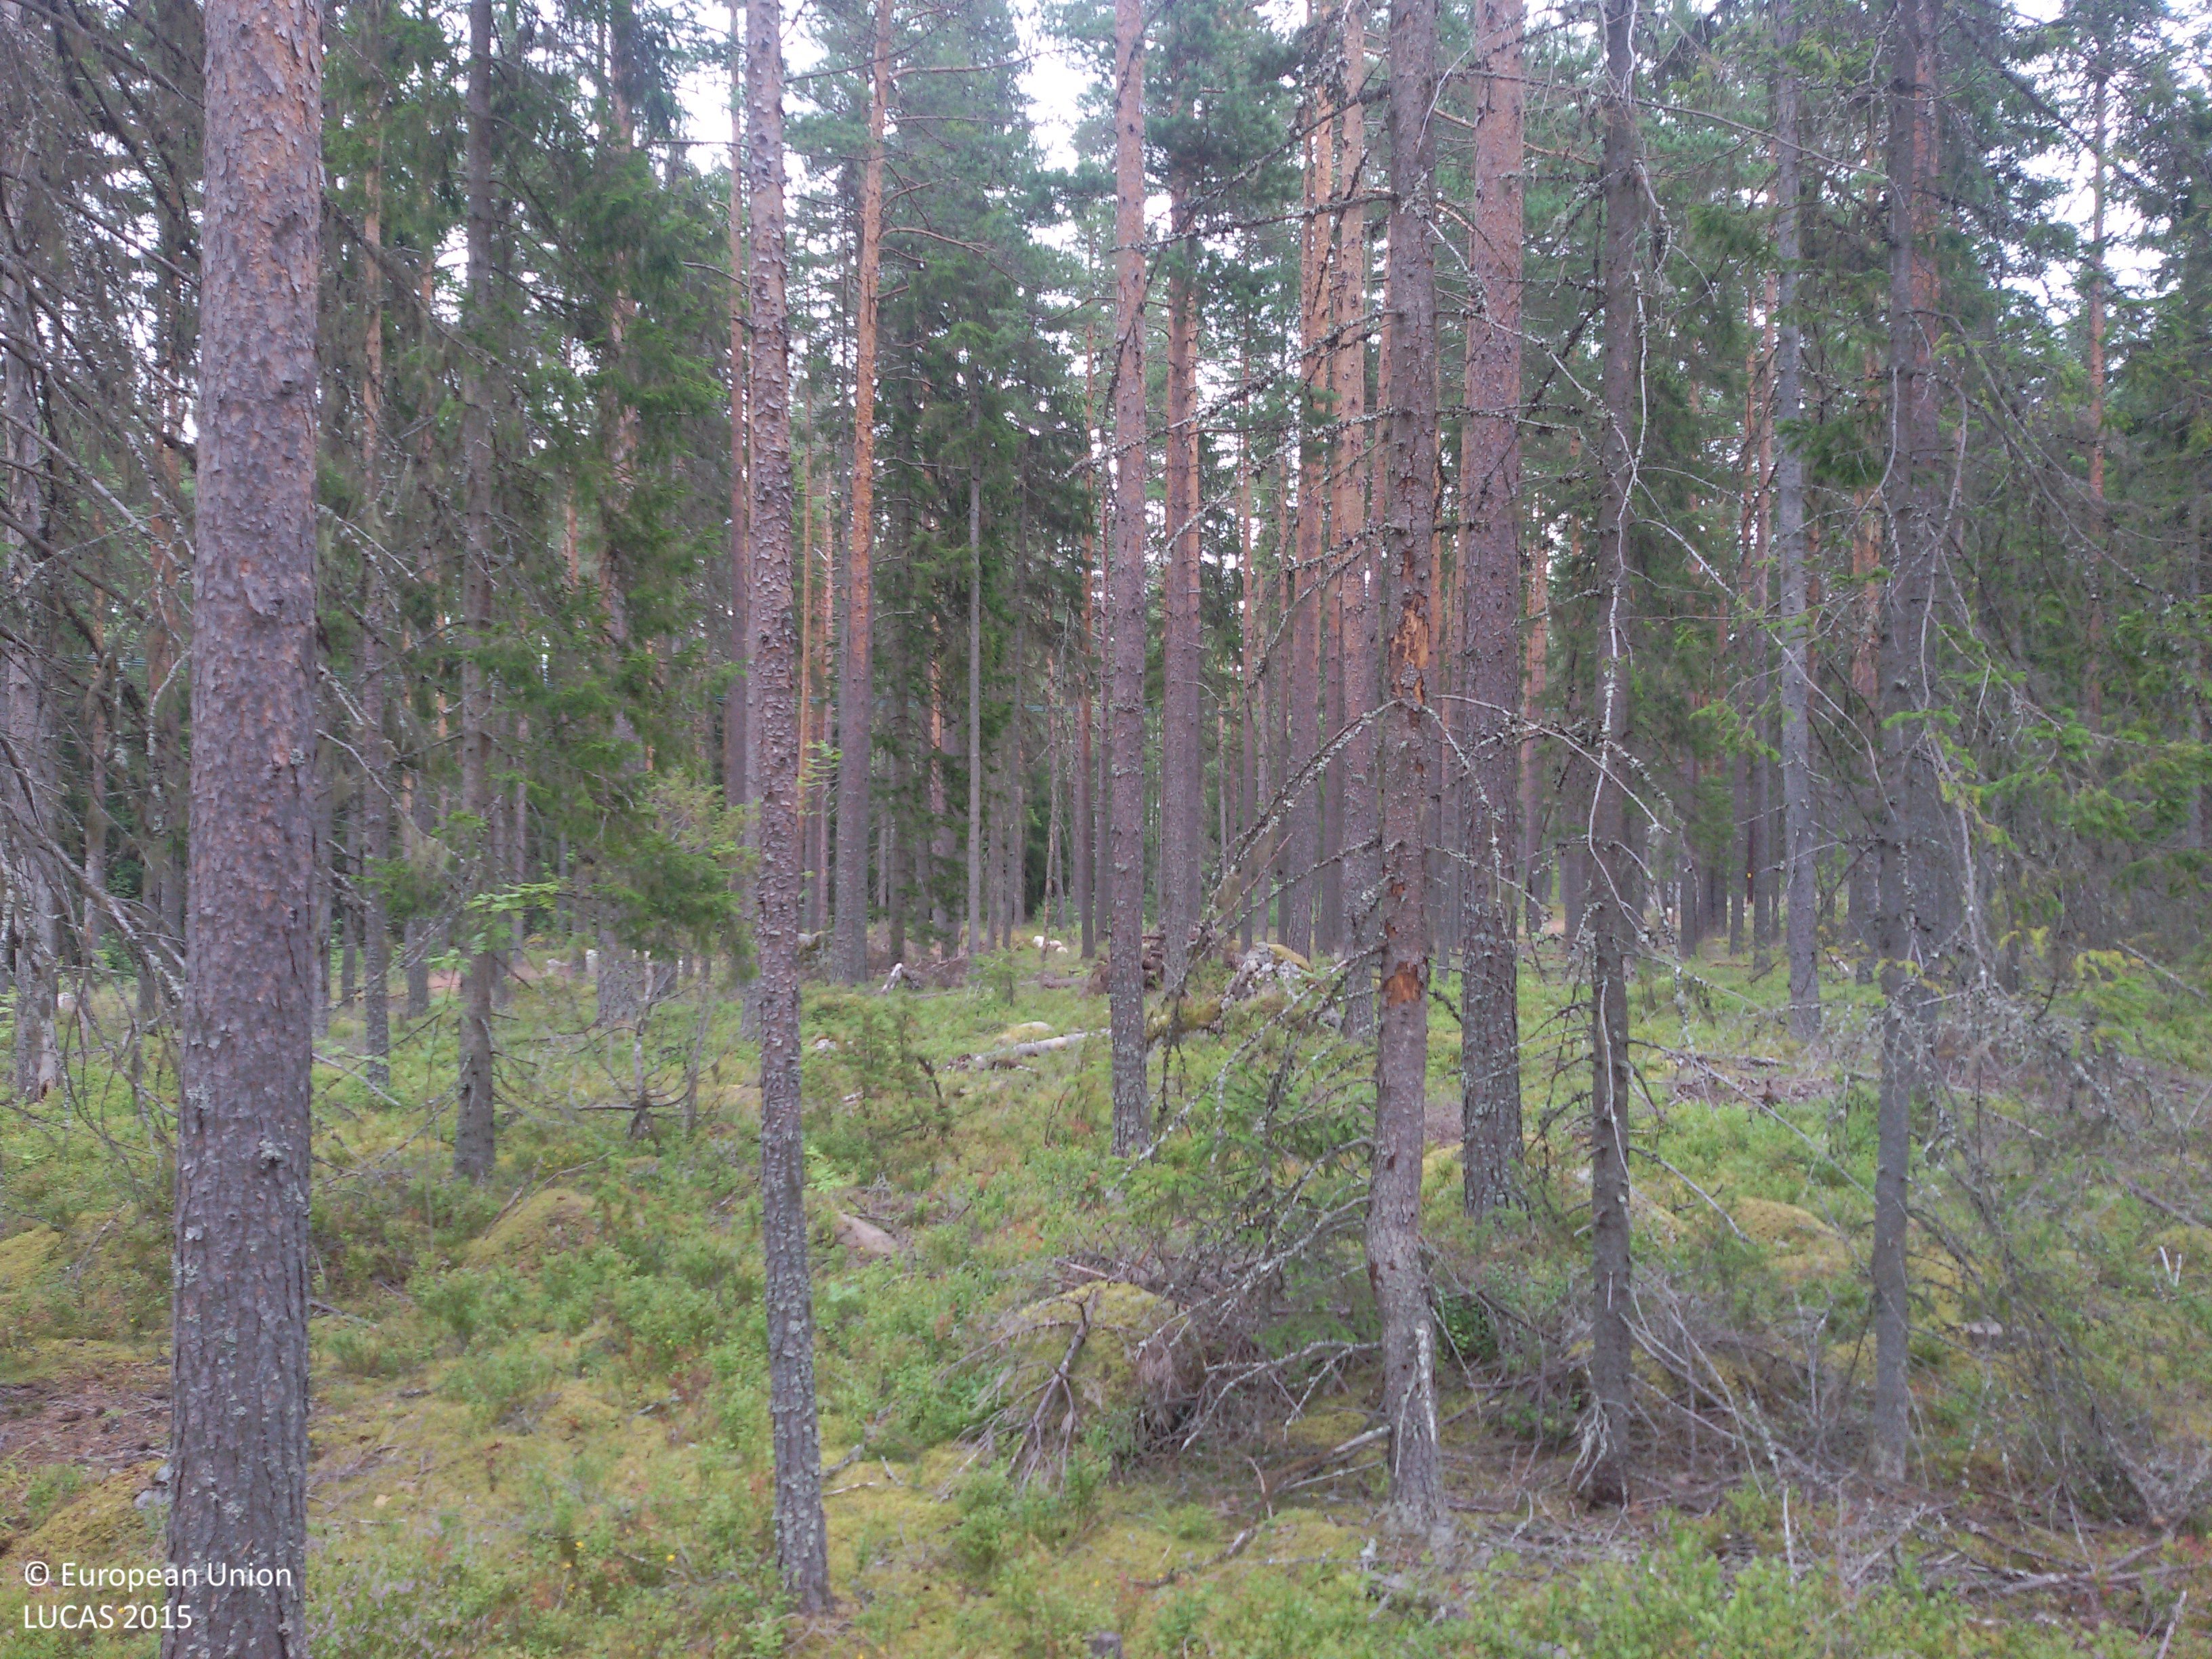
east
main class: Woodland
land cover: Pine dominated coniferous woodland
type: boreal forest
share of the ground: 50 - 75 %
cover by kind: coniferous forest trees 60 %, lichens and mosses 30 %, shrubs 10 %
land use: Forestry
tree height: > 5 m
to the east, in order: Pine dominated coniferous woodland; Electric lines; Pine dominated coniferous woodland; Tracks; Spruce dominated coniferous woodland; Broadleaved woodland; Pine dominated mixed woodland; Tracks; Spruce dominated coniferous woodland; Spruce dominated mixed woodland
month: August
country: SE
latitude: 60.6950
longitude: 16.5998
